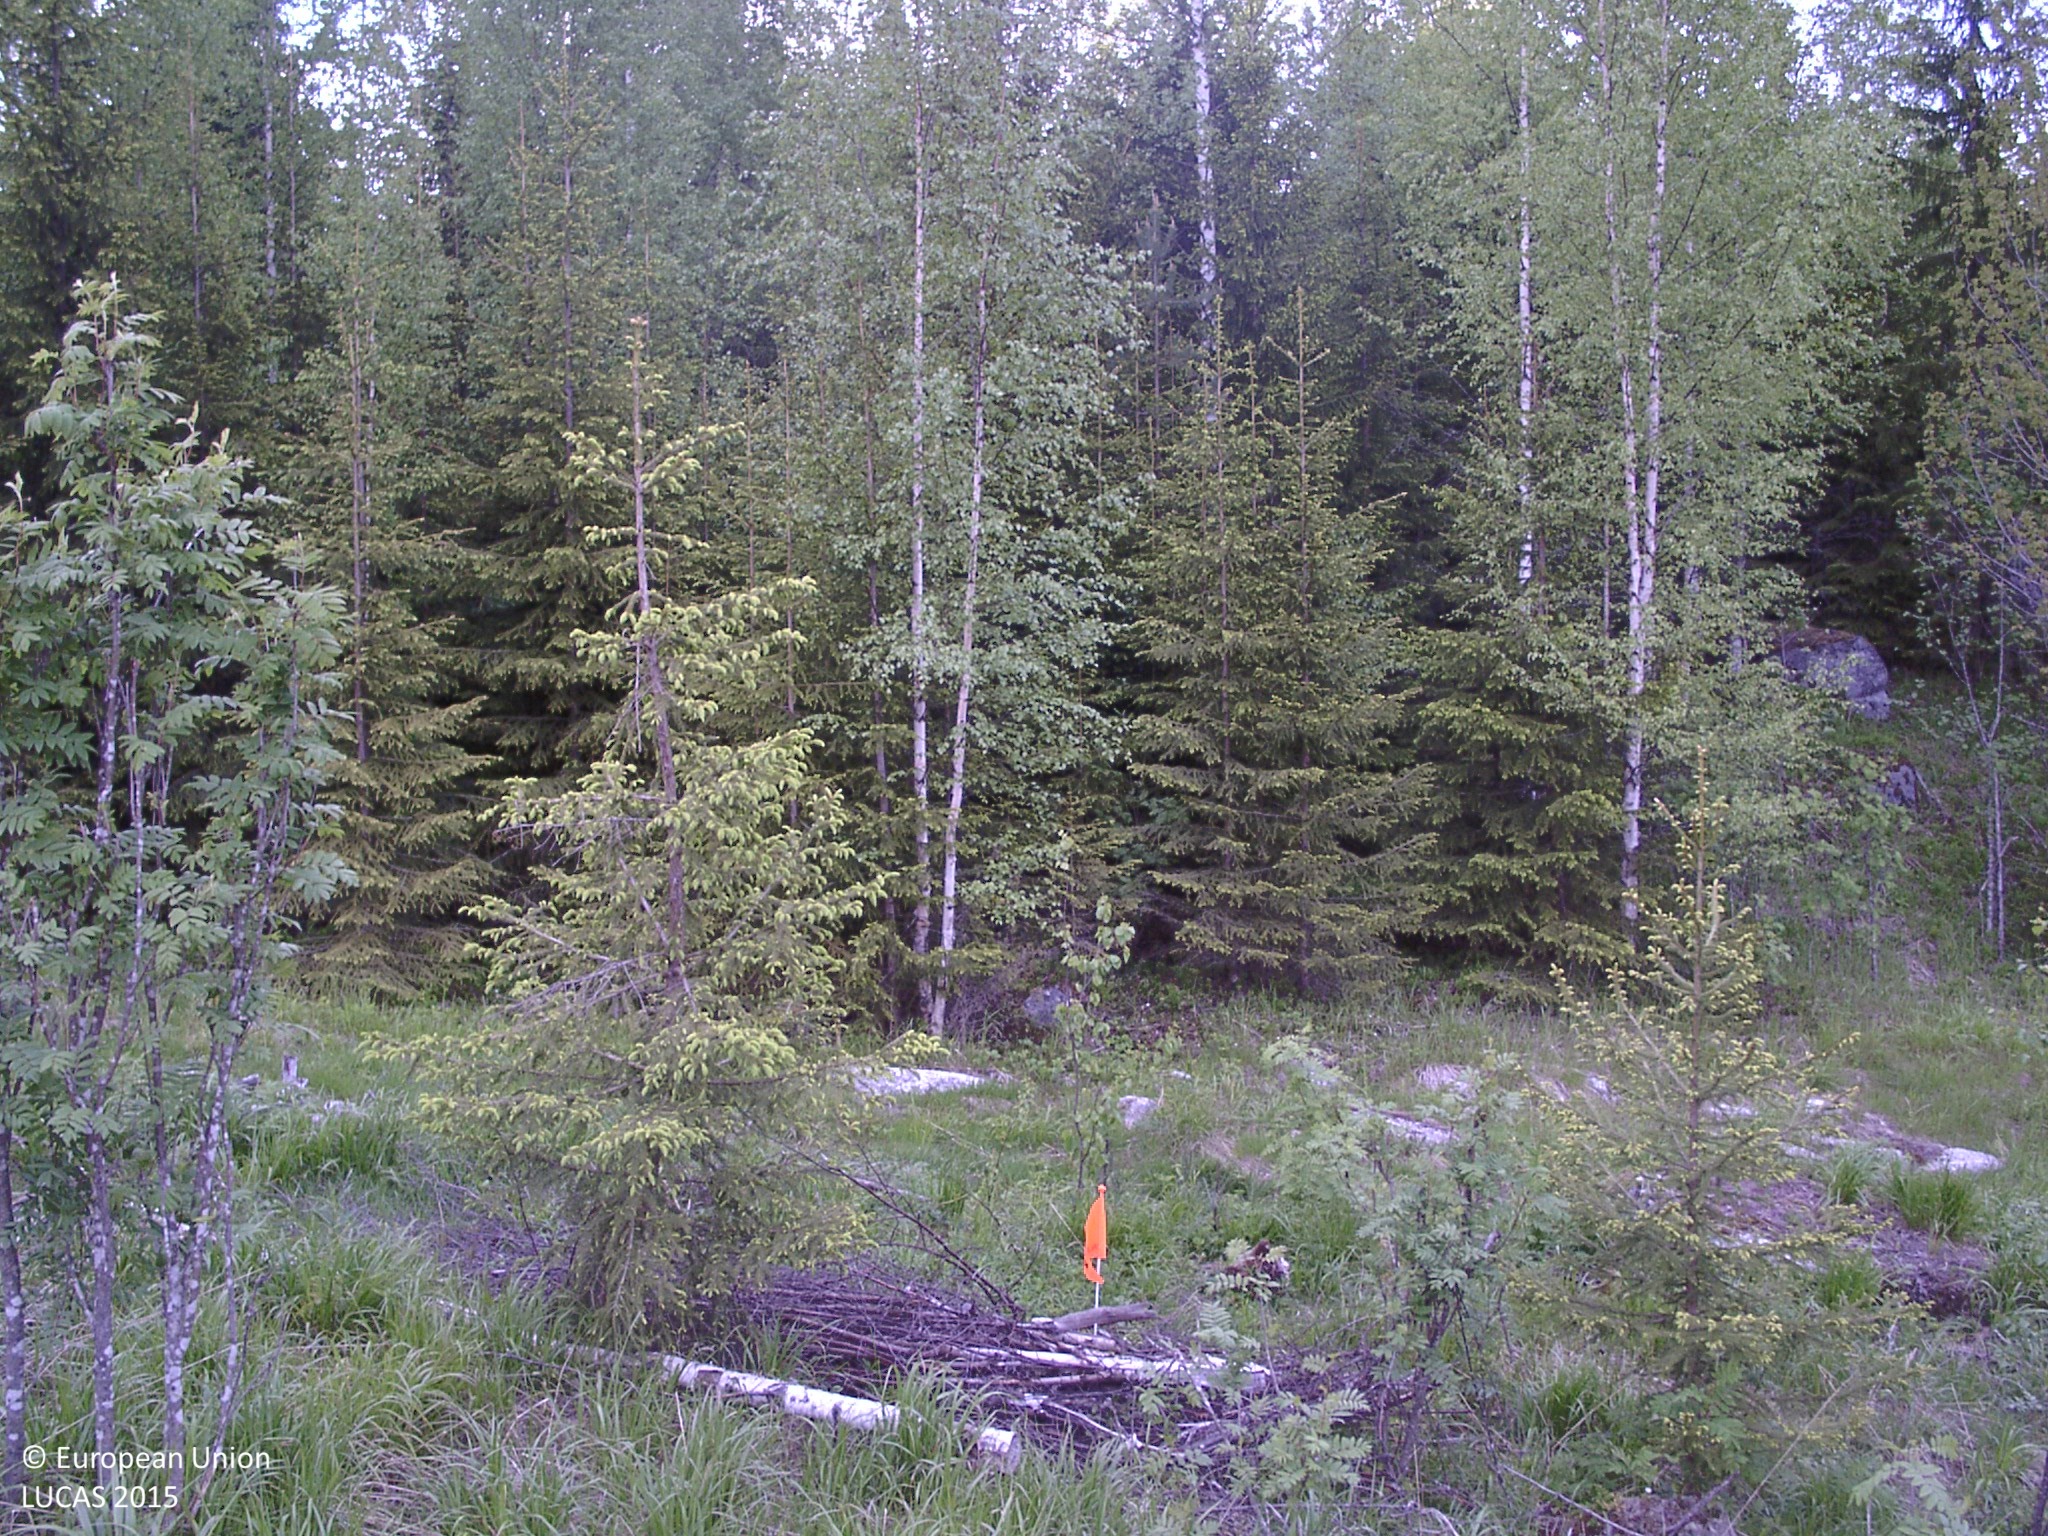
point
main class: Woodland
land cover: Broadleaved woodland
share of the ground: 10 - 25 %
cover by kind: herbaceous plants 80 %, broadleaved forest trees 20 %
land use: Forestry
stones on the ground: < 10 %
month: June
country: FI
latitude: 62.0858
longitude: 25.6089
